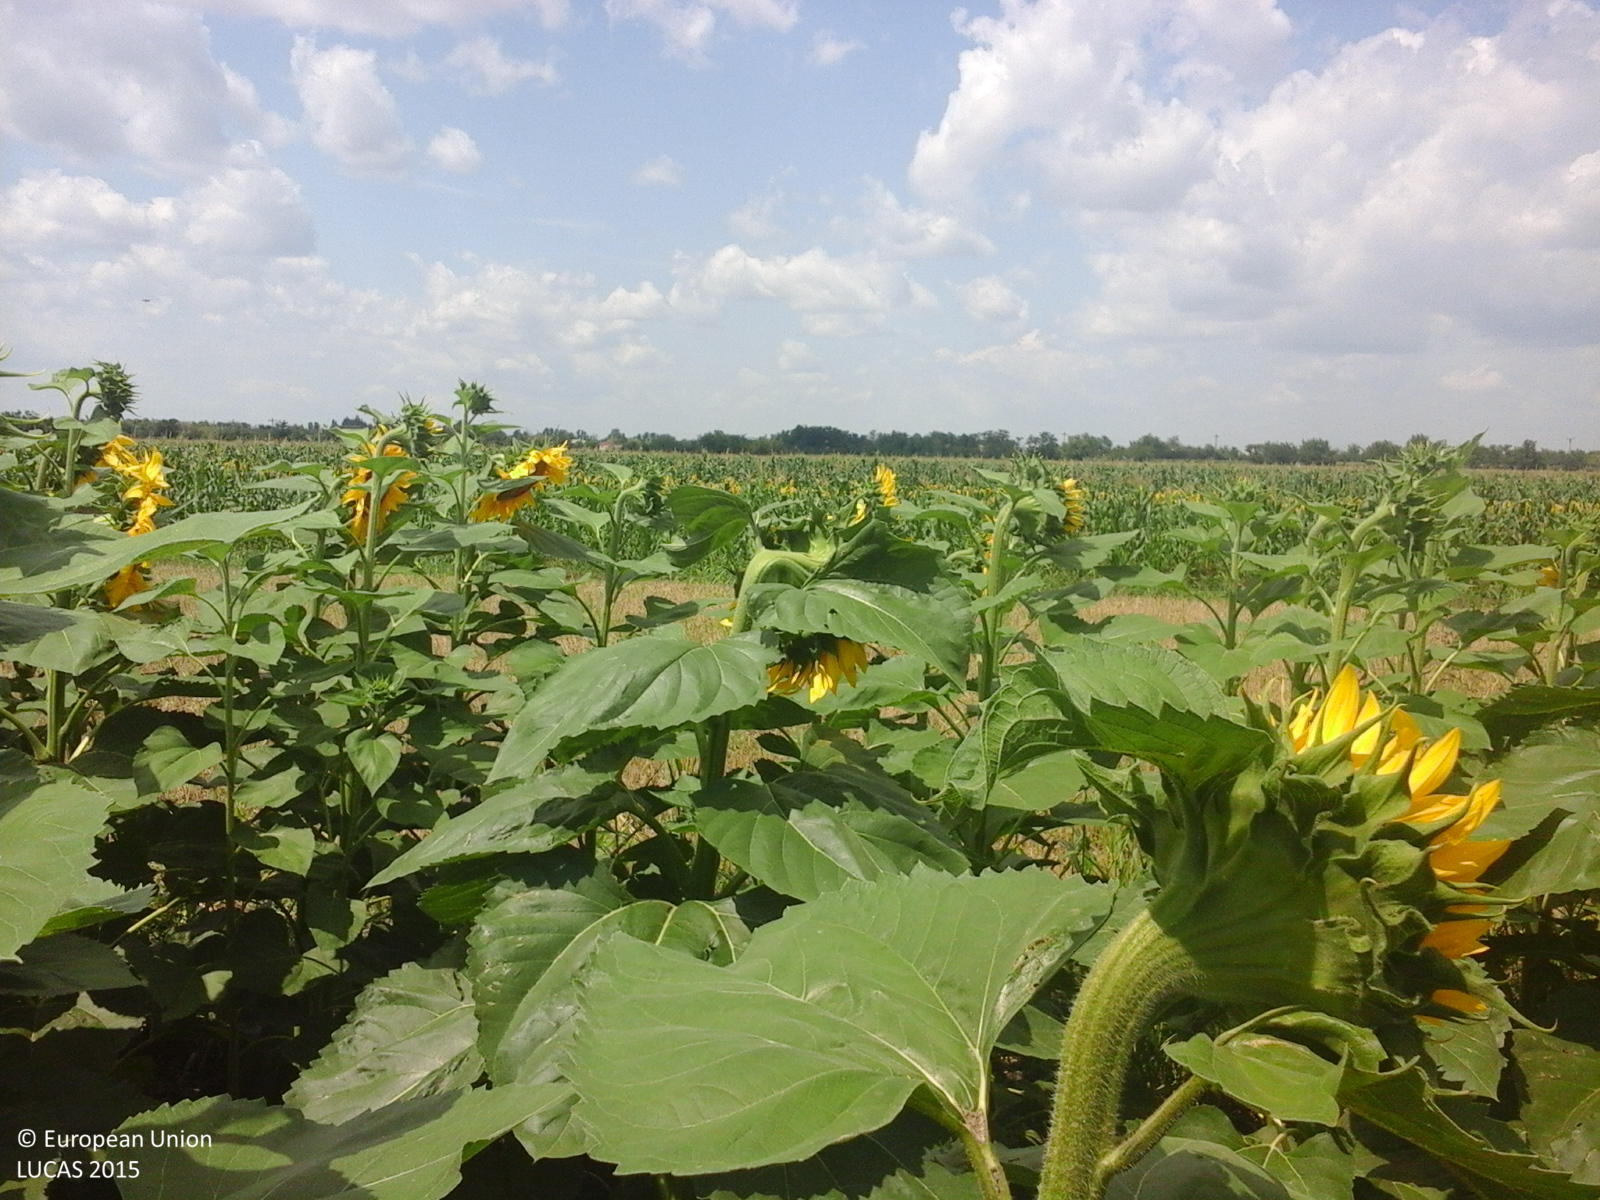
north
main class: Cropland
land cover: Sunflower
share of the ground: > 75 %
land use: Agriculture (excluding fallow land and kitchen gardens)
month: July
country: RO
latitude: 43.8549
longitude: 24.3820
